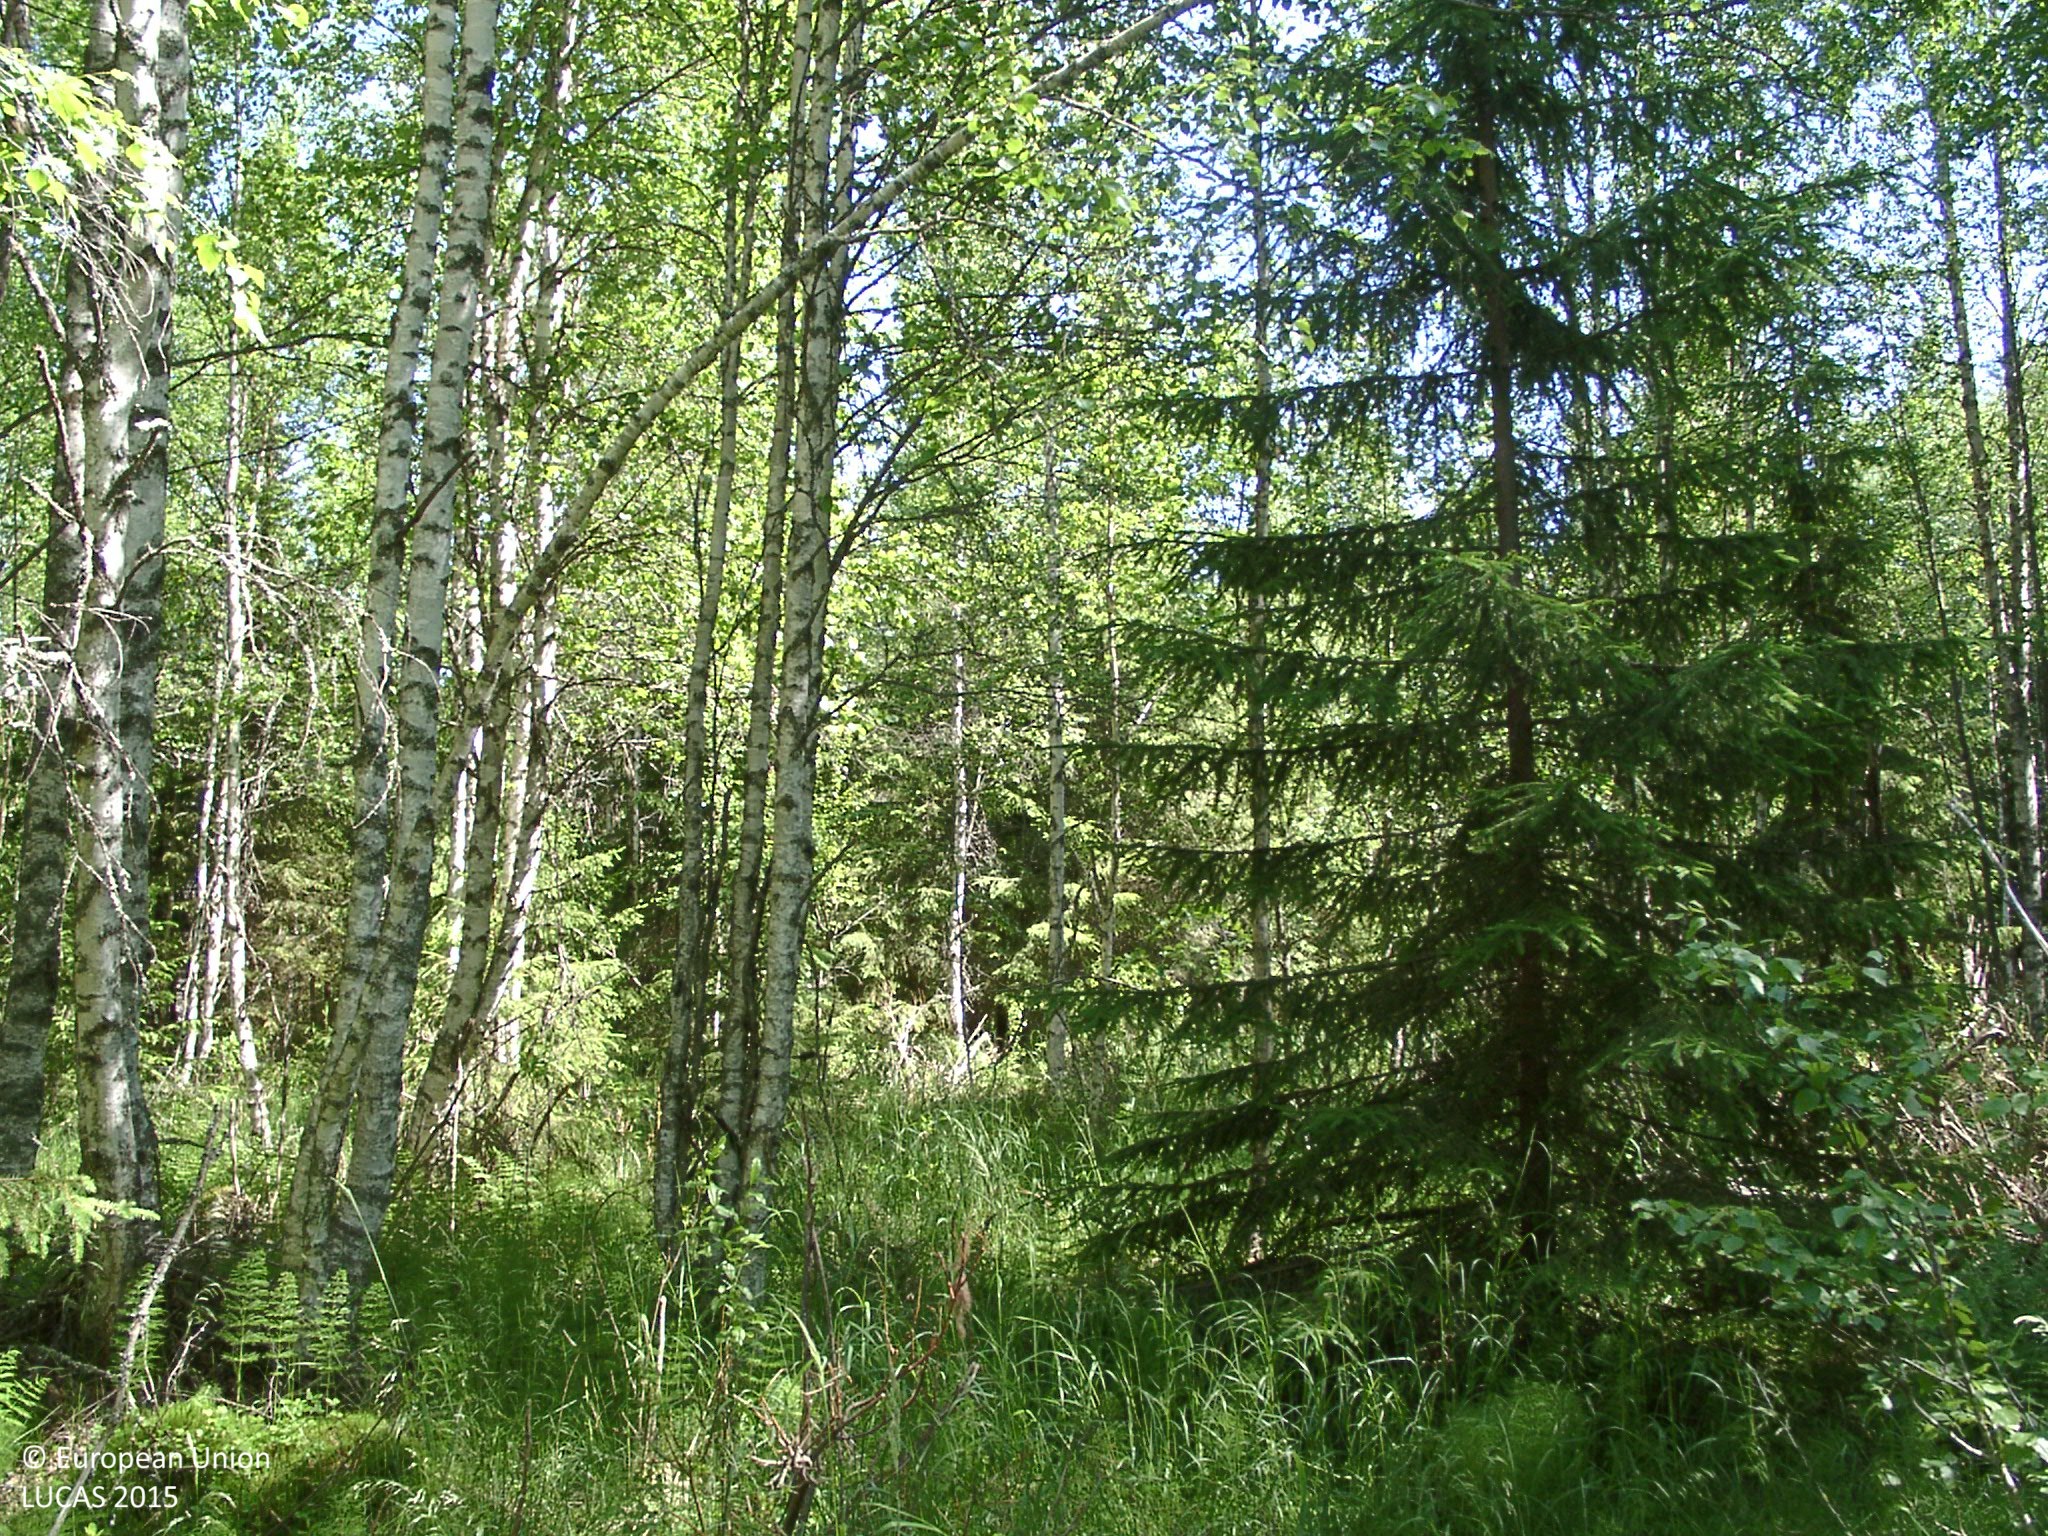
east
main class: Woodland
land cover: Spruce dominated mixed woodland
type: non-riverine alder, birch or aspen forest
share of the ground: 25 - 50 %
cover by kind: herbaceous plants 60 %, broadleaved forest trees 30 %, coniferous forest trees 10 %
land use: Forestry
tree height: > 5 m
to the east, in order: Spruce dominated mixed woodland; Other mixed woodland; Rivers and streams; Other mixed woodland; Grassland with sparse tree/shrub cover; Pine dominated mixed woodland; Spruce dominated mixed woodland; Ditches and canals; Spruce dominated mixed woodland; Ditches and canals; Spruce dominated mixed woodland; Pine dominated mixed woodland
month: July
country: FI
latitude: 62.0549
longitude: 25.2012
